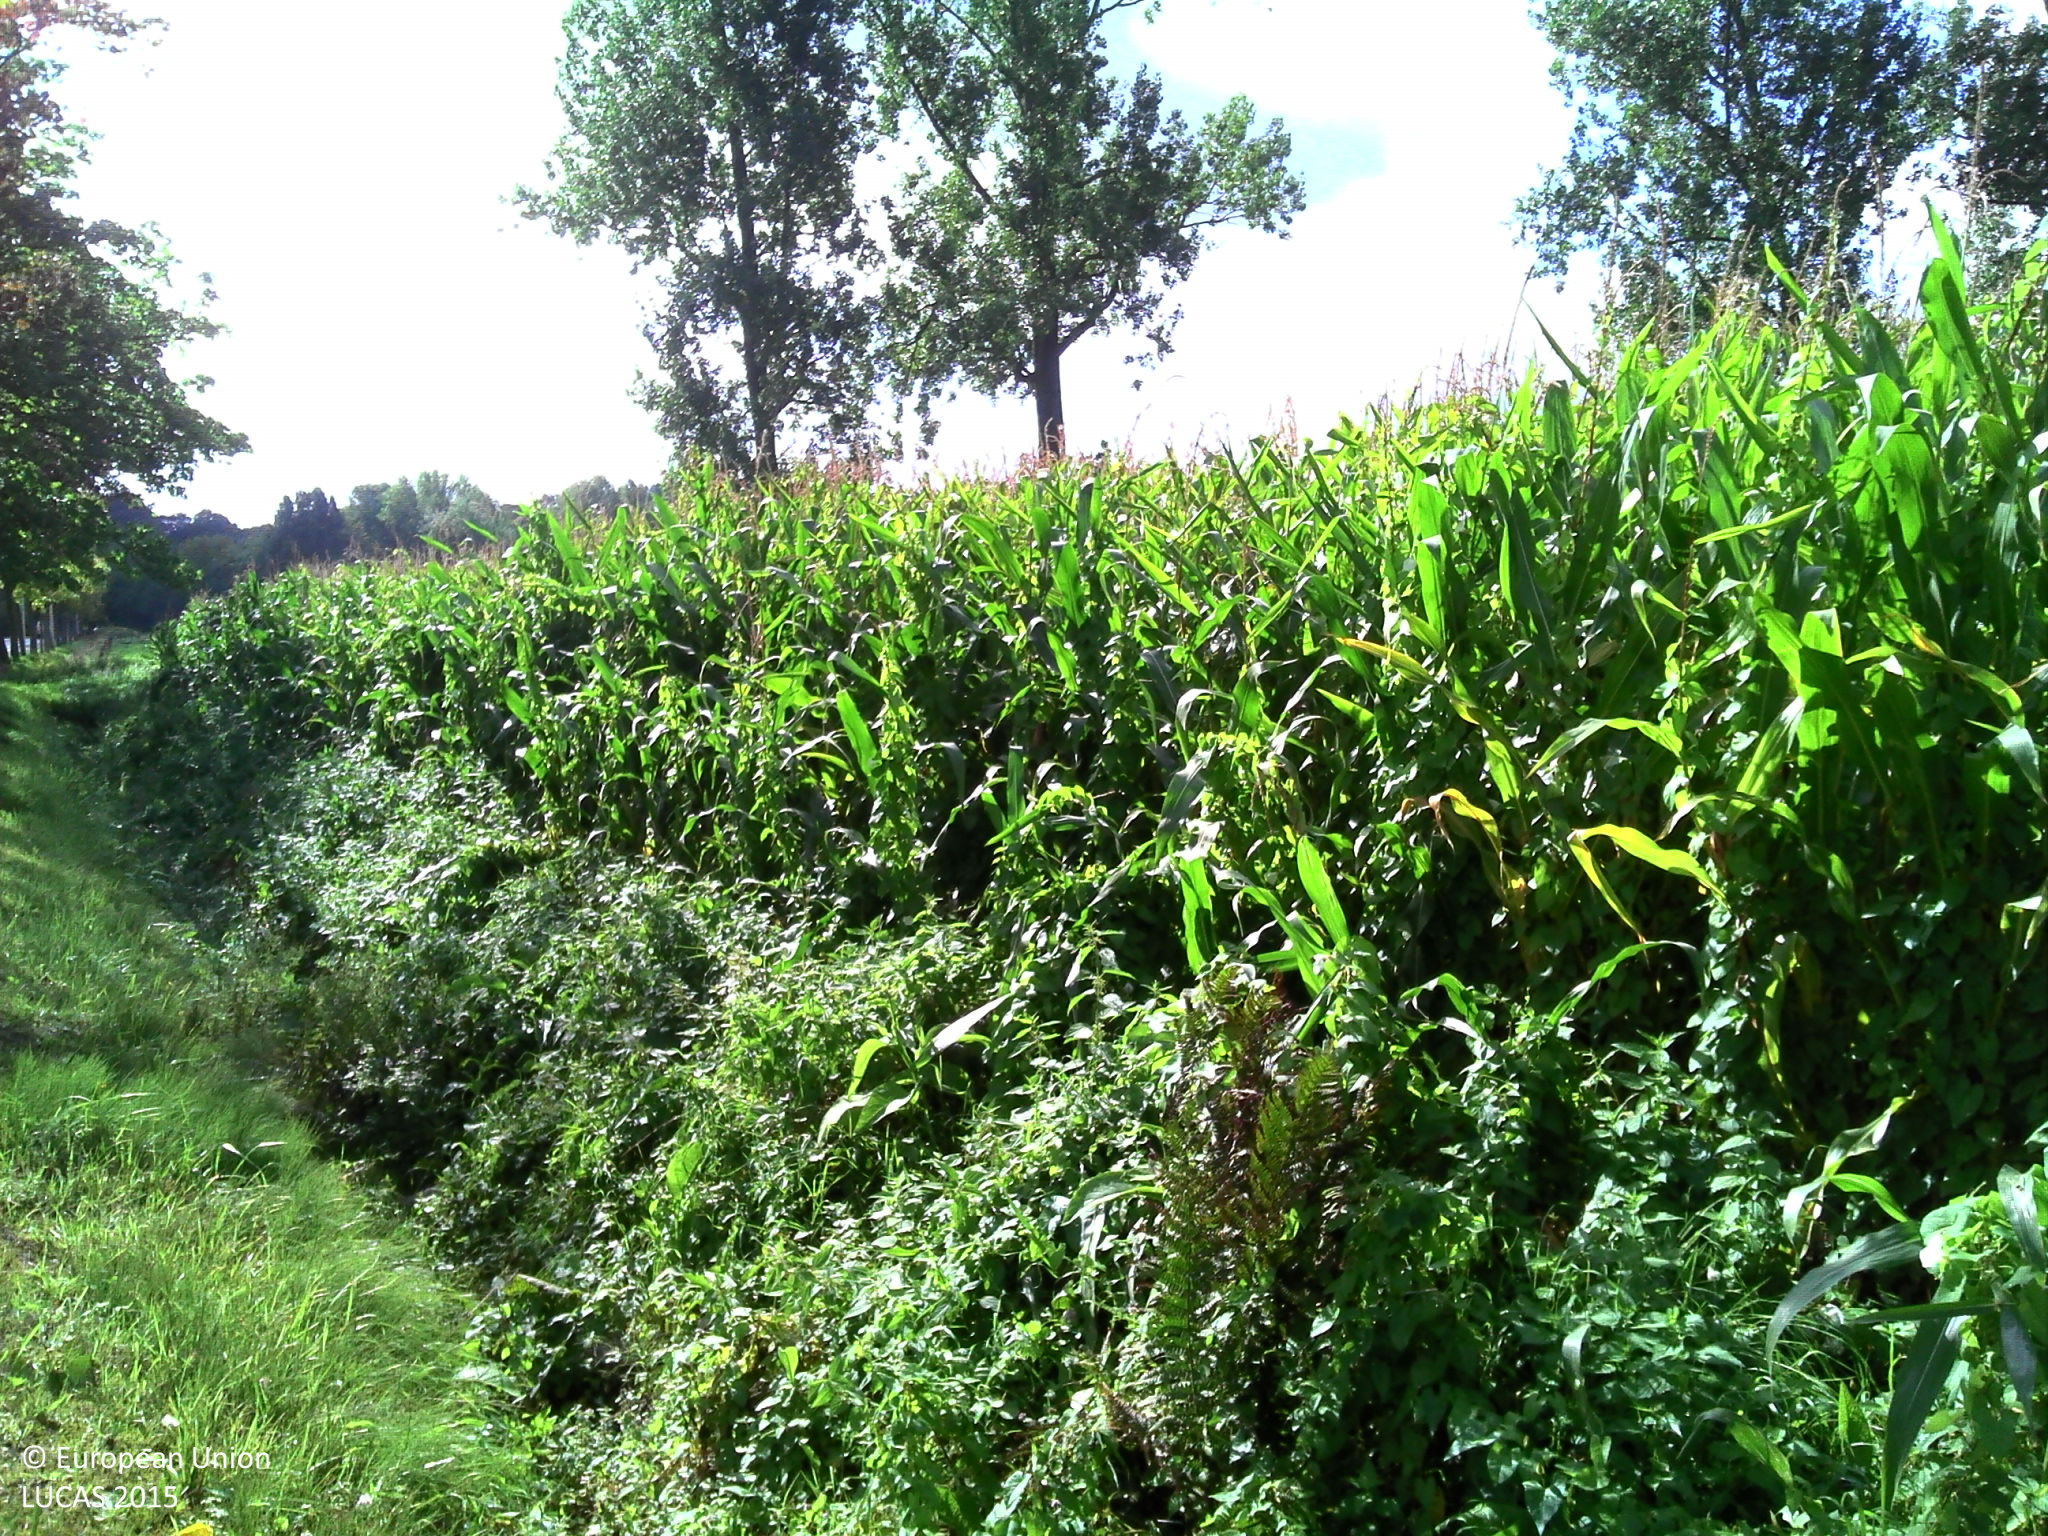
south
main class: Cropland
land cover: Maize
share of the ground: > 75 %
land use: Agriculture (excluding fallow land and kitchen gardens)
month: September
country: BE
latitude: 51.1464
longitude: 4.4062
